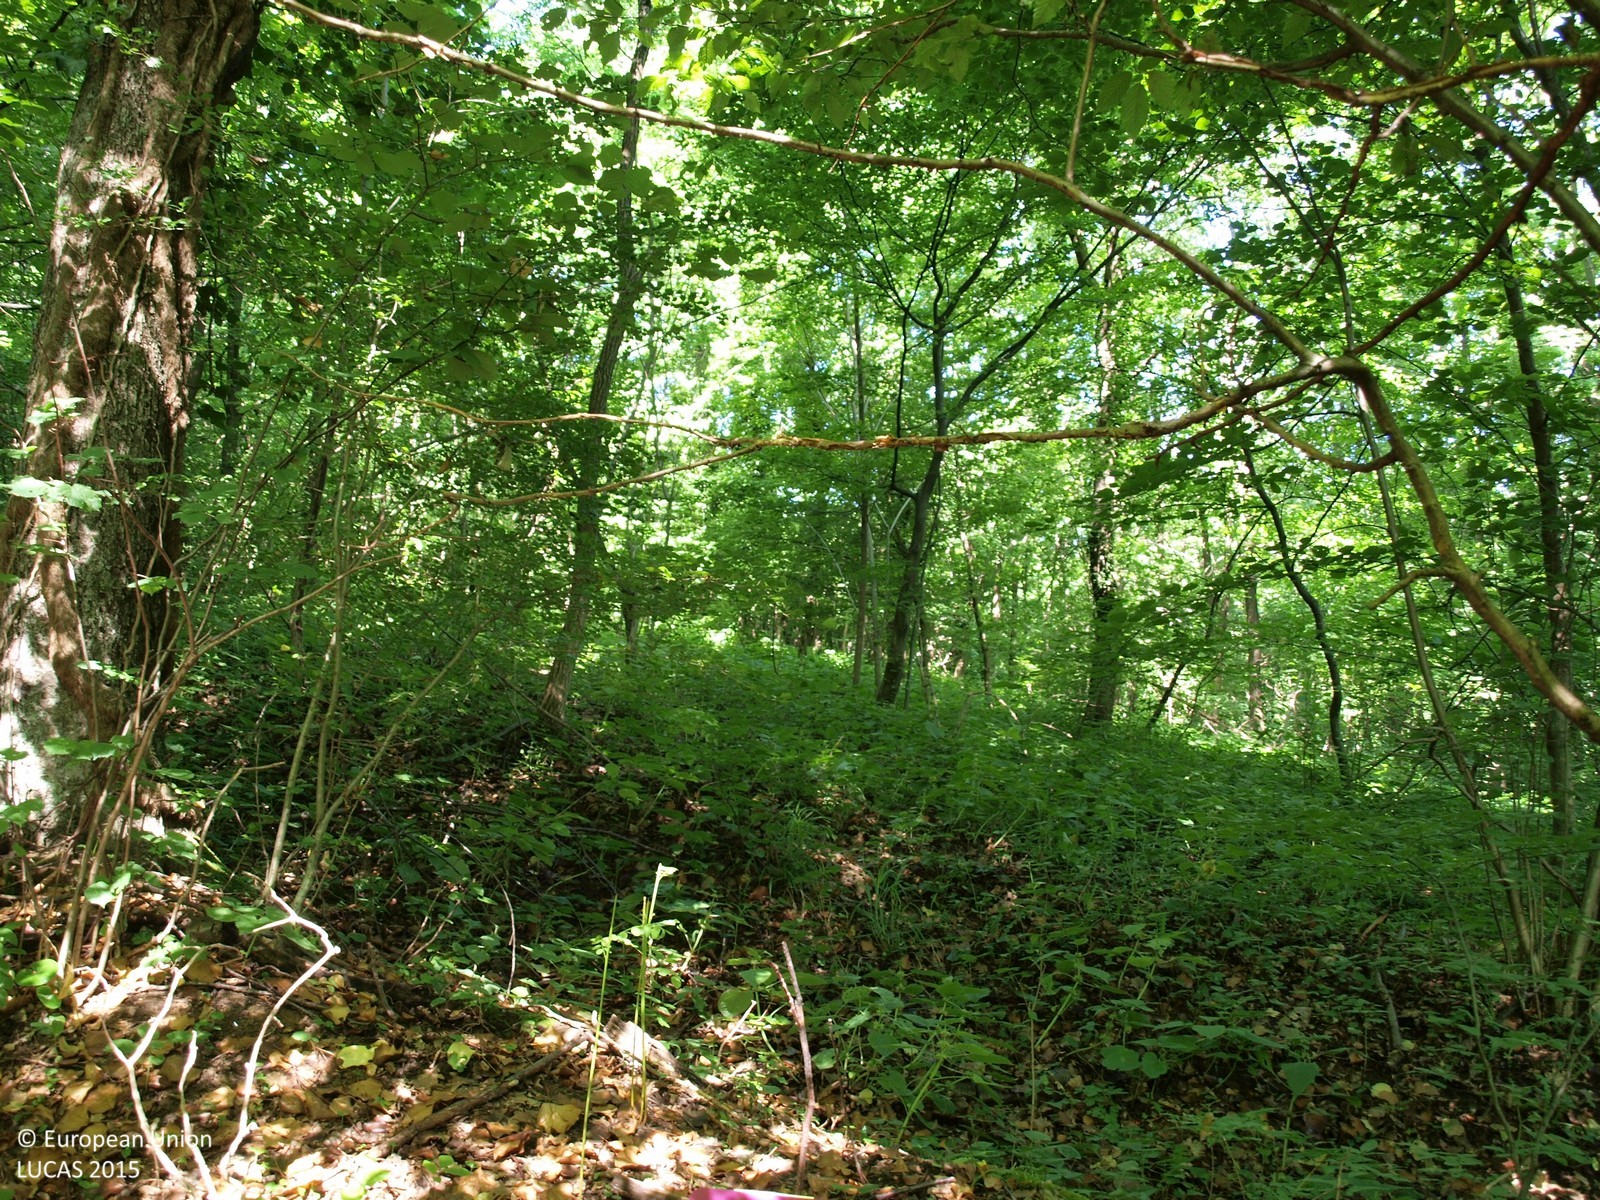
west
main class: Woodland
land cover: Broadleaved woodland
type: mesophytic deciduous forest
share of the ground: > 75 %
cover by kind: broadleaved forest trees 100 %
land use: Forestry
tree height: > 5 m
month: June
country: HR
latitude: 46.1778
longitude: 15.7629
